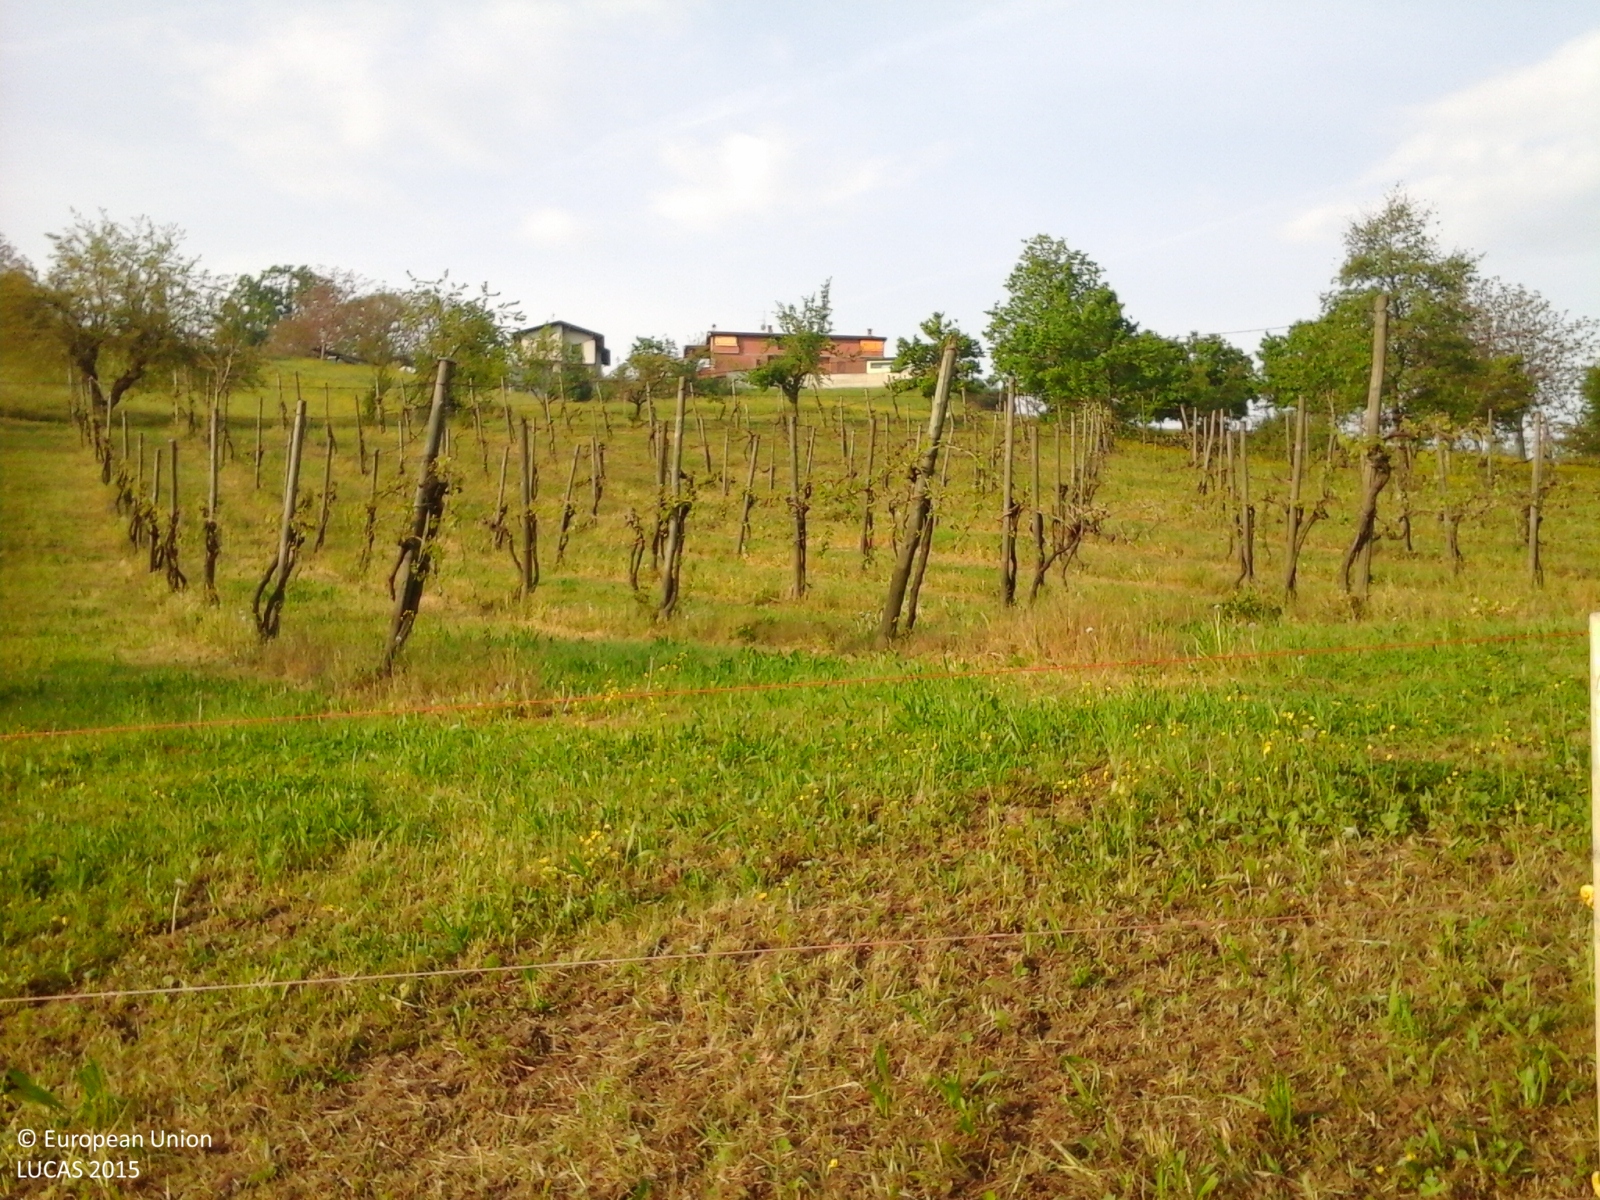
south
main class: Woodland
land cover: Broadleaved woodland
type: mesophytic deciduous forest
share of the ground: > 75 %
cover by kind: broadleaved forest trees 70 %, shrubs 30 %
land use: Semi-natural and natural areas not in use
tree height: > 5 m
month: April
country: IT
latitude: 44.5284
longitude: 10.7157
